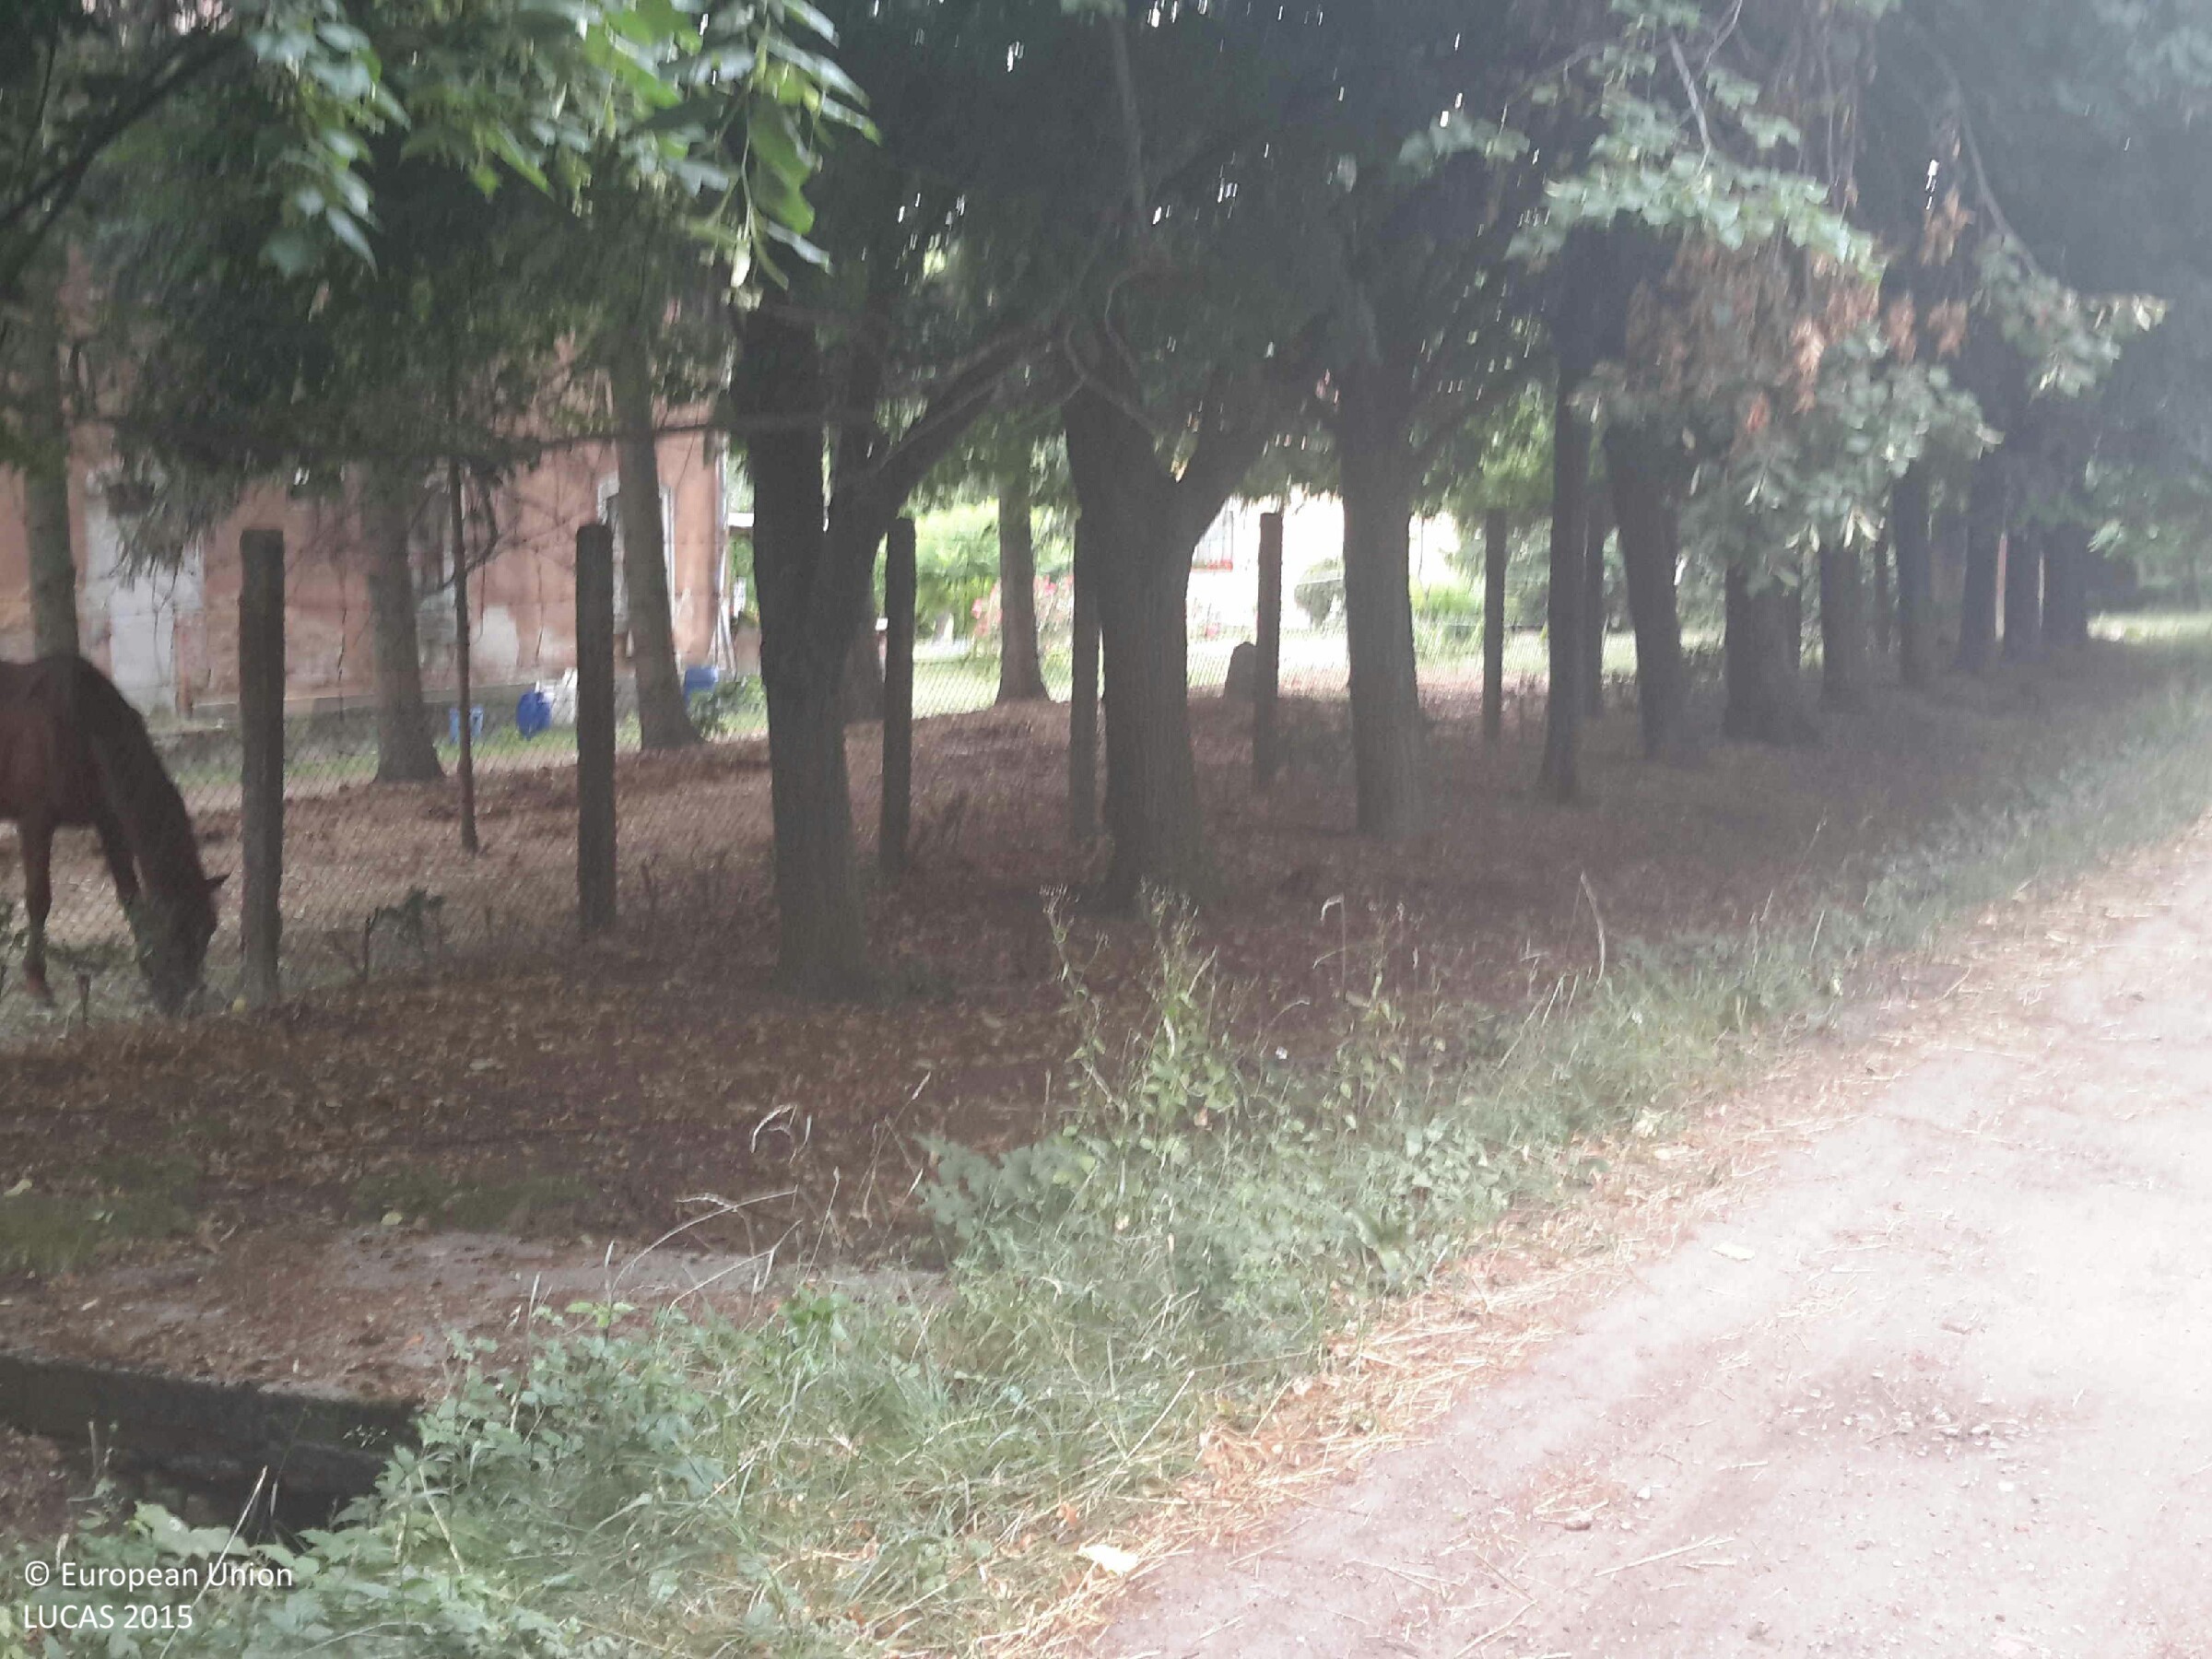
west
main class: Woodland
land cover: Broadleaved woodland
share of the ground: 25 - 50 %
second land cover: Grassland without tree/shrub cover
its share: 50 - 75 %
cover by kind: herbaceous plants 60 %, broadleaved forest trees 40 %
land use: Agriculture (excluding fallow land and kitchen gardens)
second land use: Amenities, museums, leisure
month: July
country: HU
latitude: 47.5688
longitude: 16.6908
